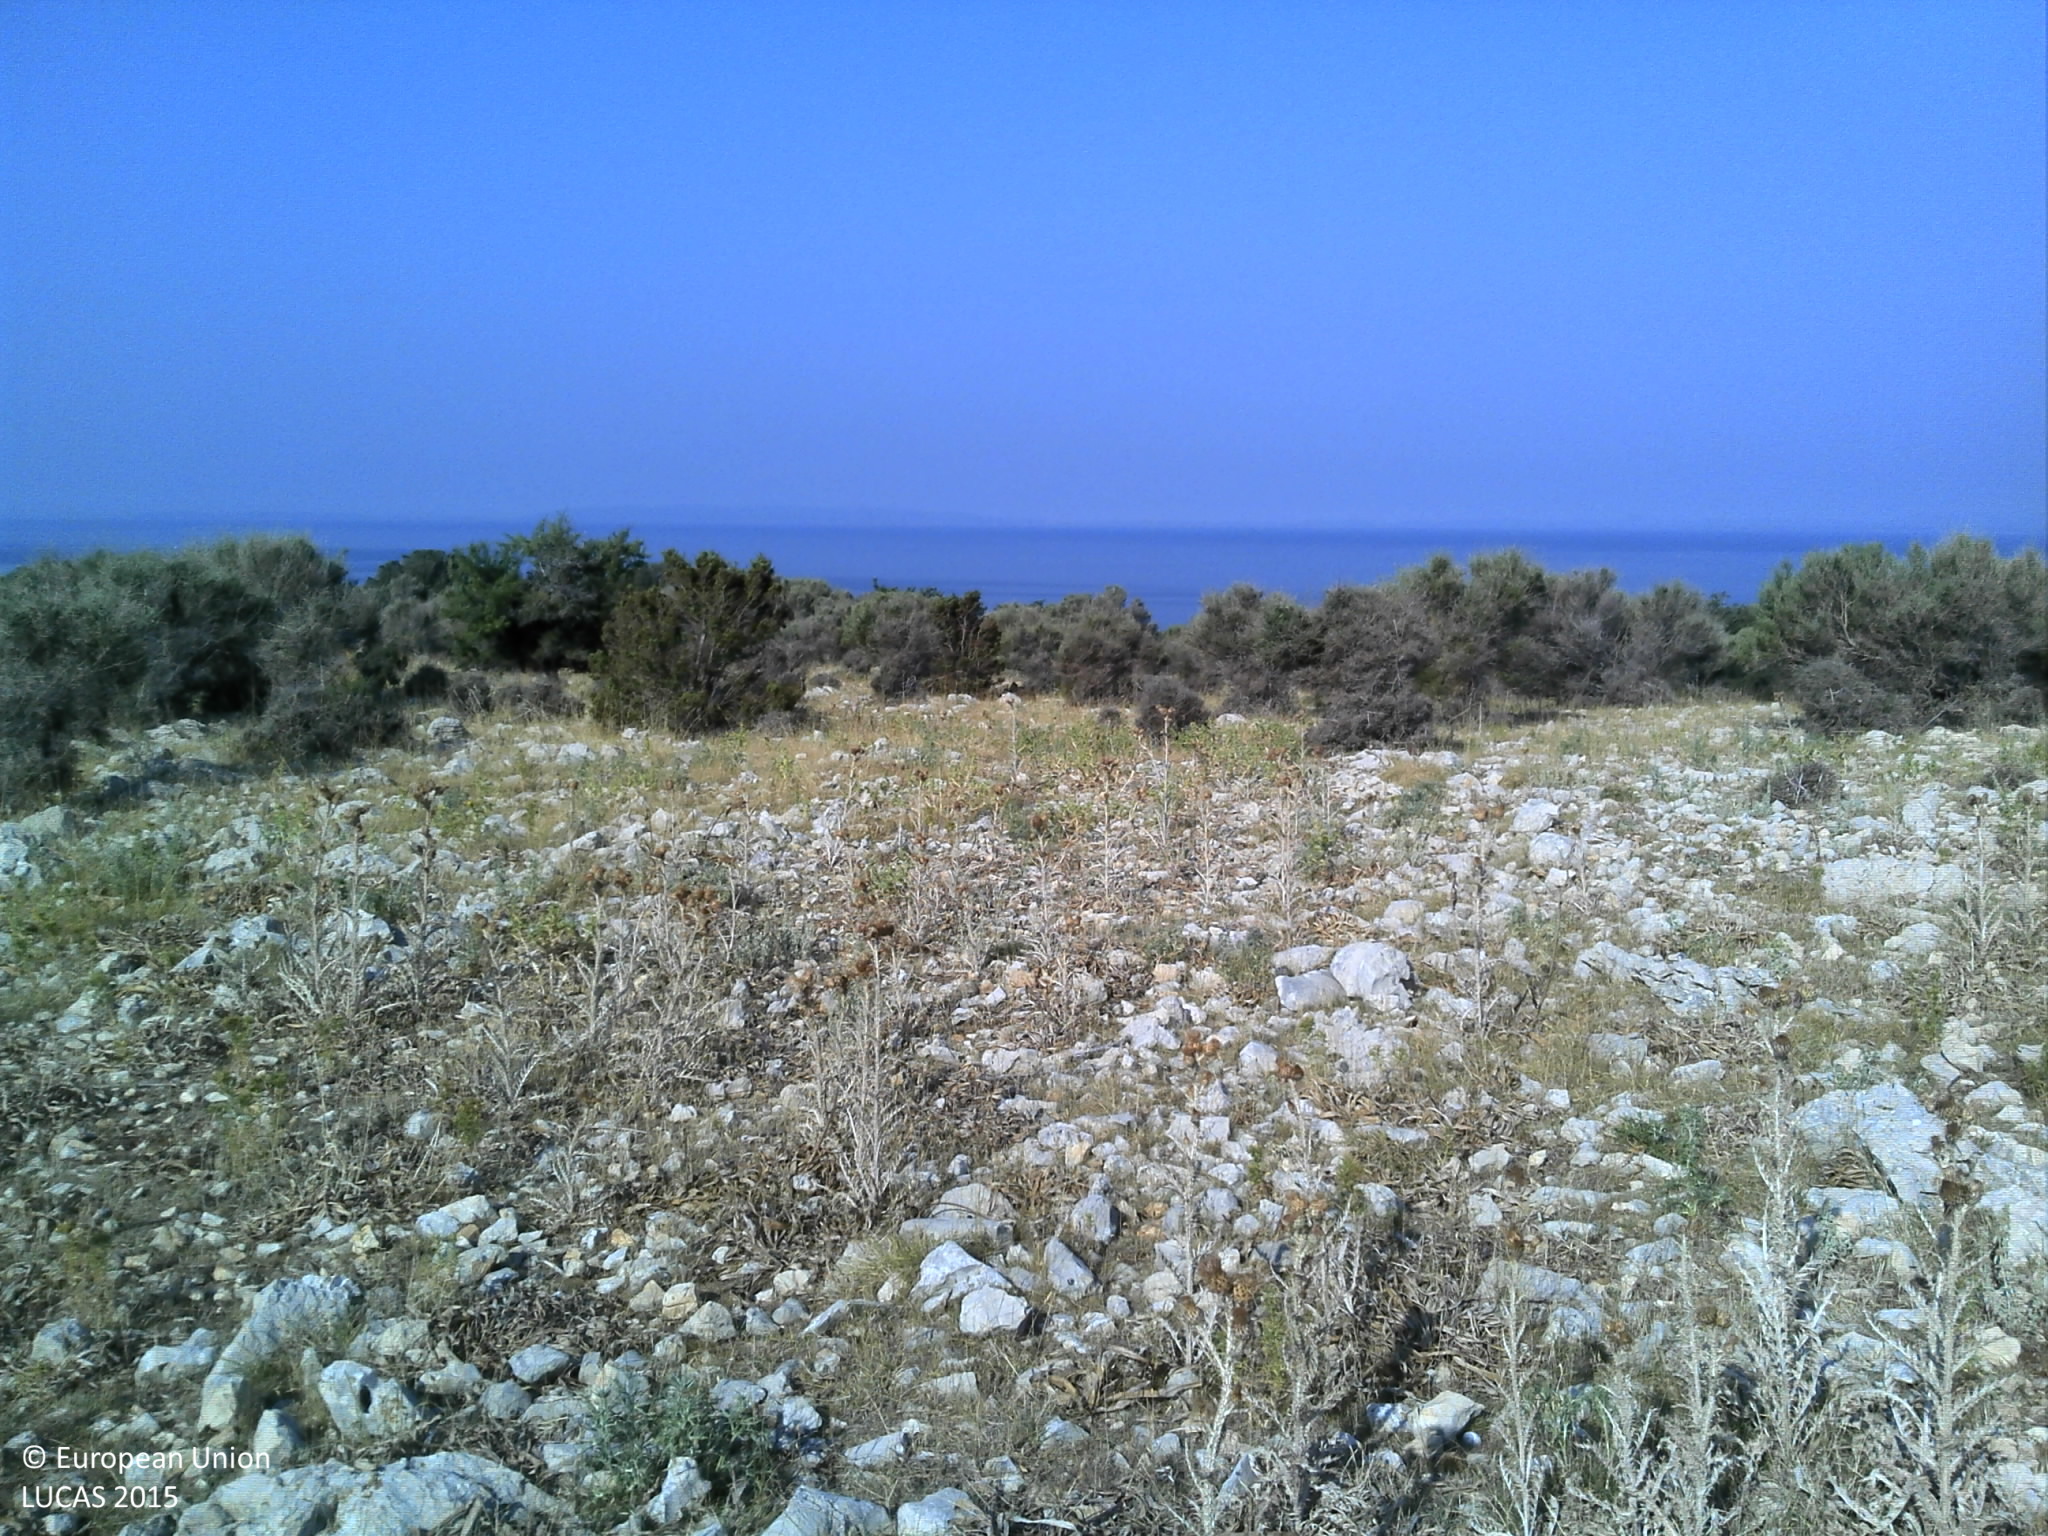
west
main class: Grassland
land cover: Grassland with sparse tree/shrub cover
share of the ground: 25 - 50 %
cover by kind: unconsolidated bare surface 40 %, herbaceous plants 35 %, consolidated bare surface 15 %, broadleaved forest trees 5 %, shrubs 5 %
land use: Agriculture (excluding fallow land and kitchen gardens)
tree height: < 5 m
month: July
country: HR
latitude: 44.6371
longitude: 14.7964
